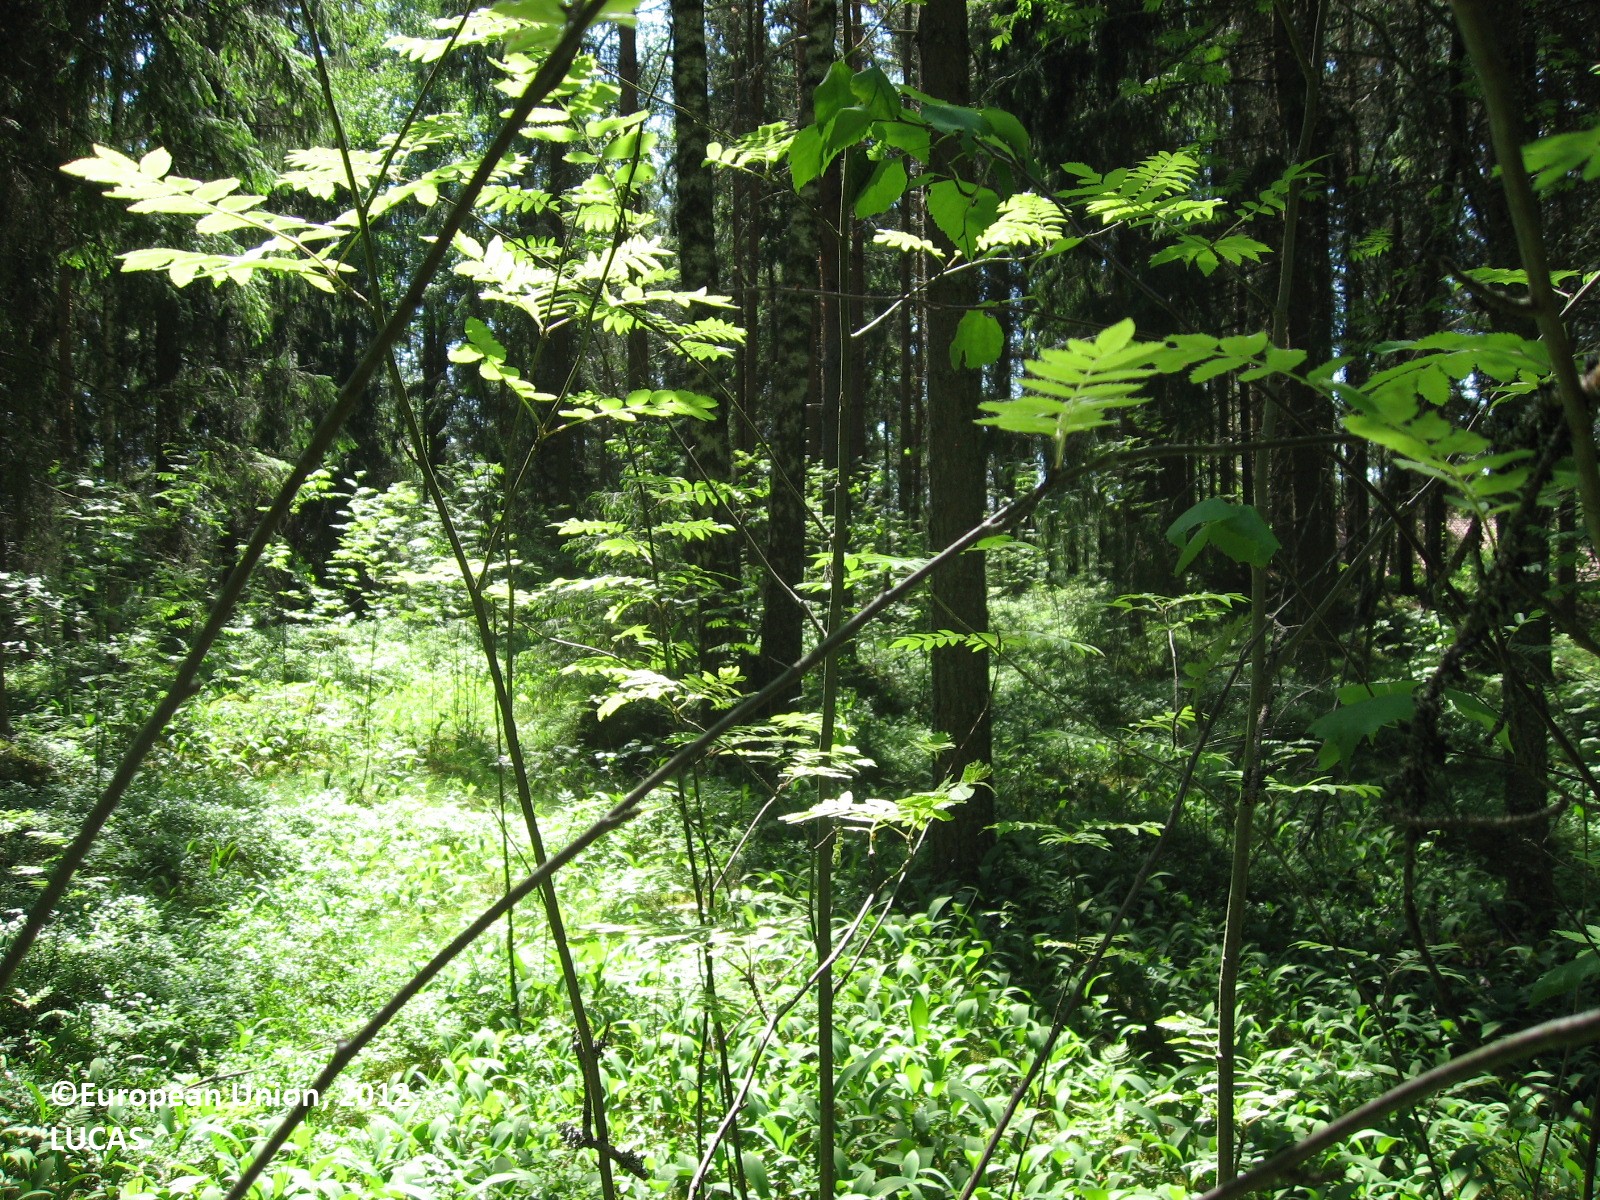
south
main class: Woodland
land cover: Spruce dominated mixed woodland
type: boreal forest
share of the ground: > 75 %
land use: Forestry
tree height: > 5 m
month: June
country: FI
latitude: 60.5643
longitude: 25.0208
